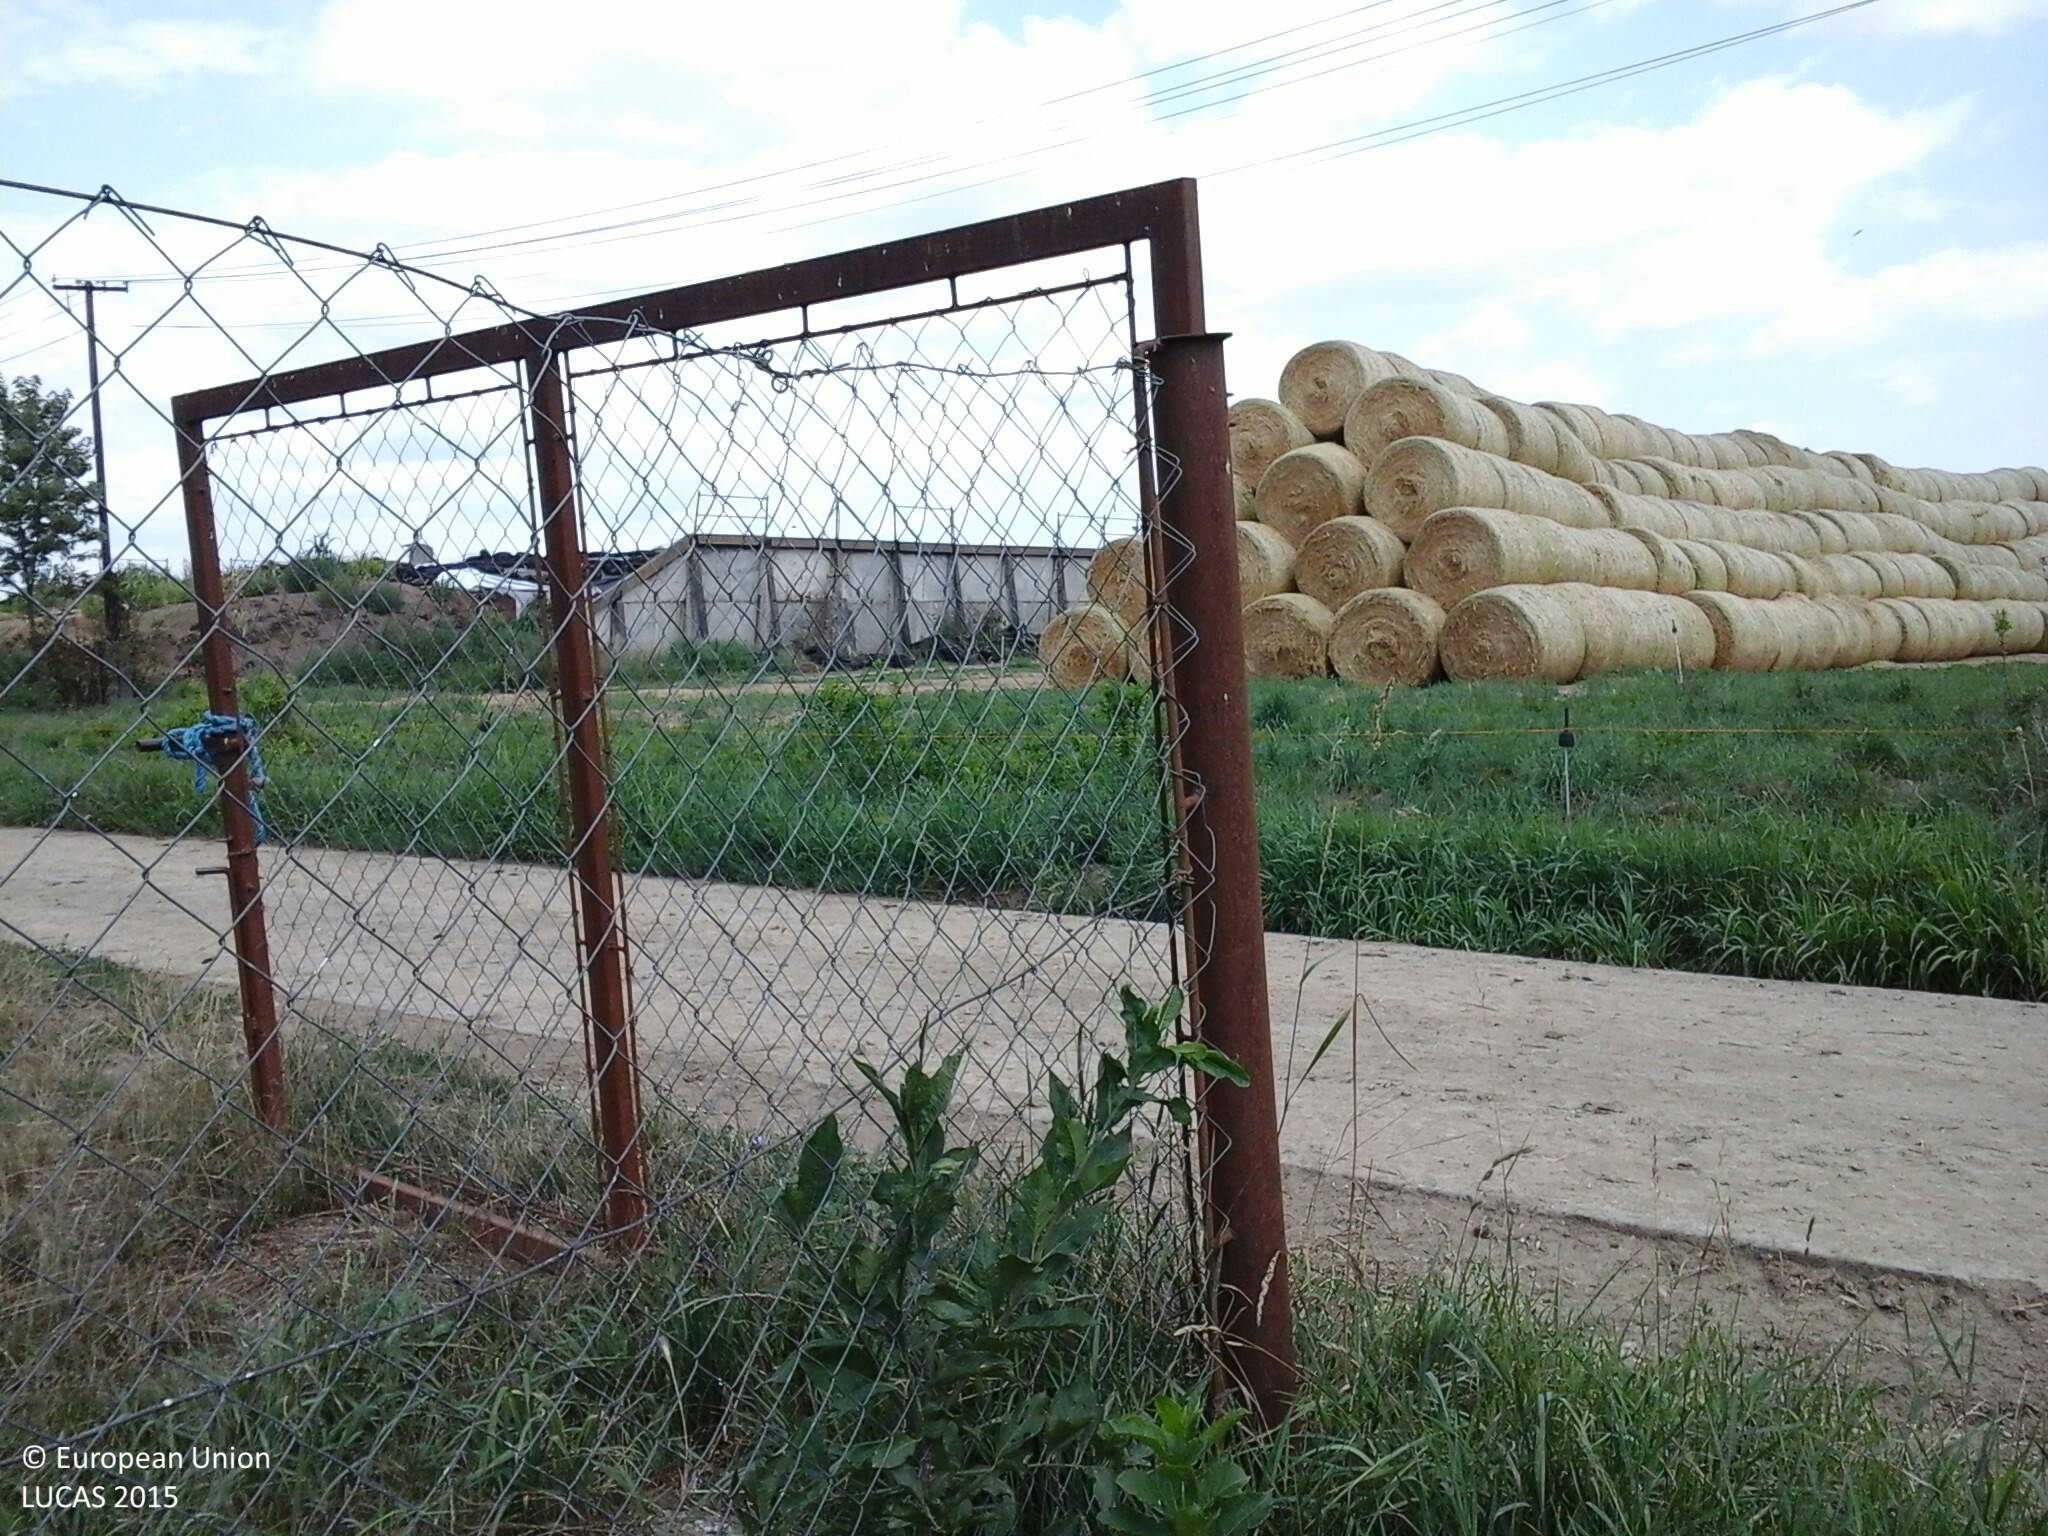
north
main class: Grassland
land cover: Grassland without tree/shrub cover
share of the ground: > 75 %
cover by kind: herbaceous plants 95 %, shrubs 5 %
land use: Road transport
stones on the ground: < 10 %
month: July
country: HU
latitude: 47.0196
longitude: 16.5148
